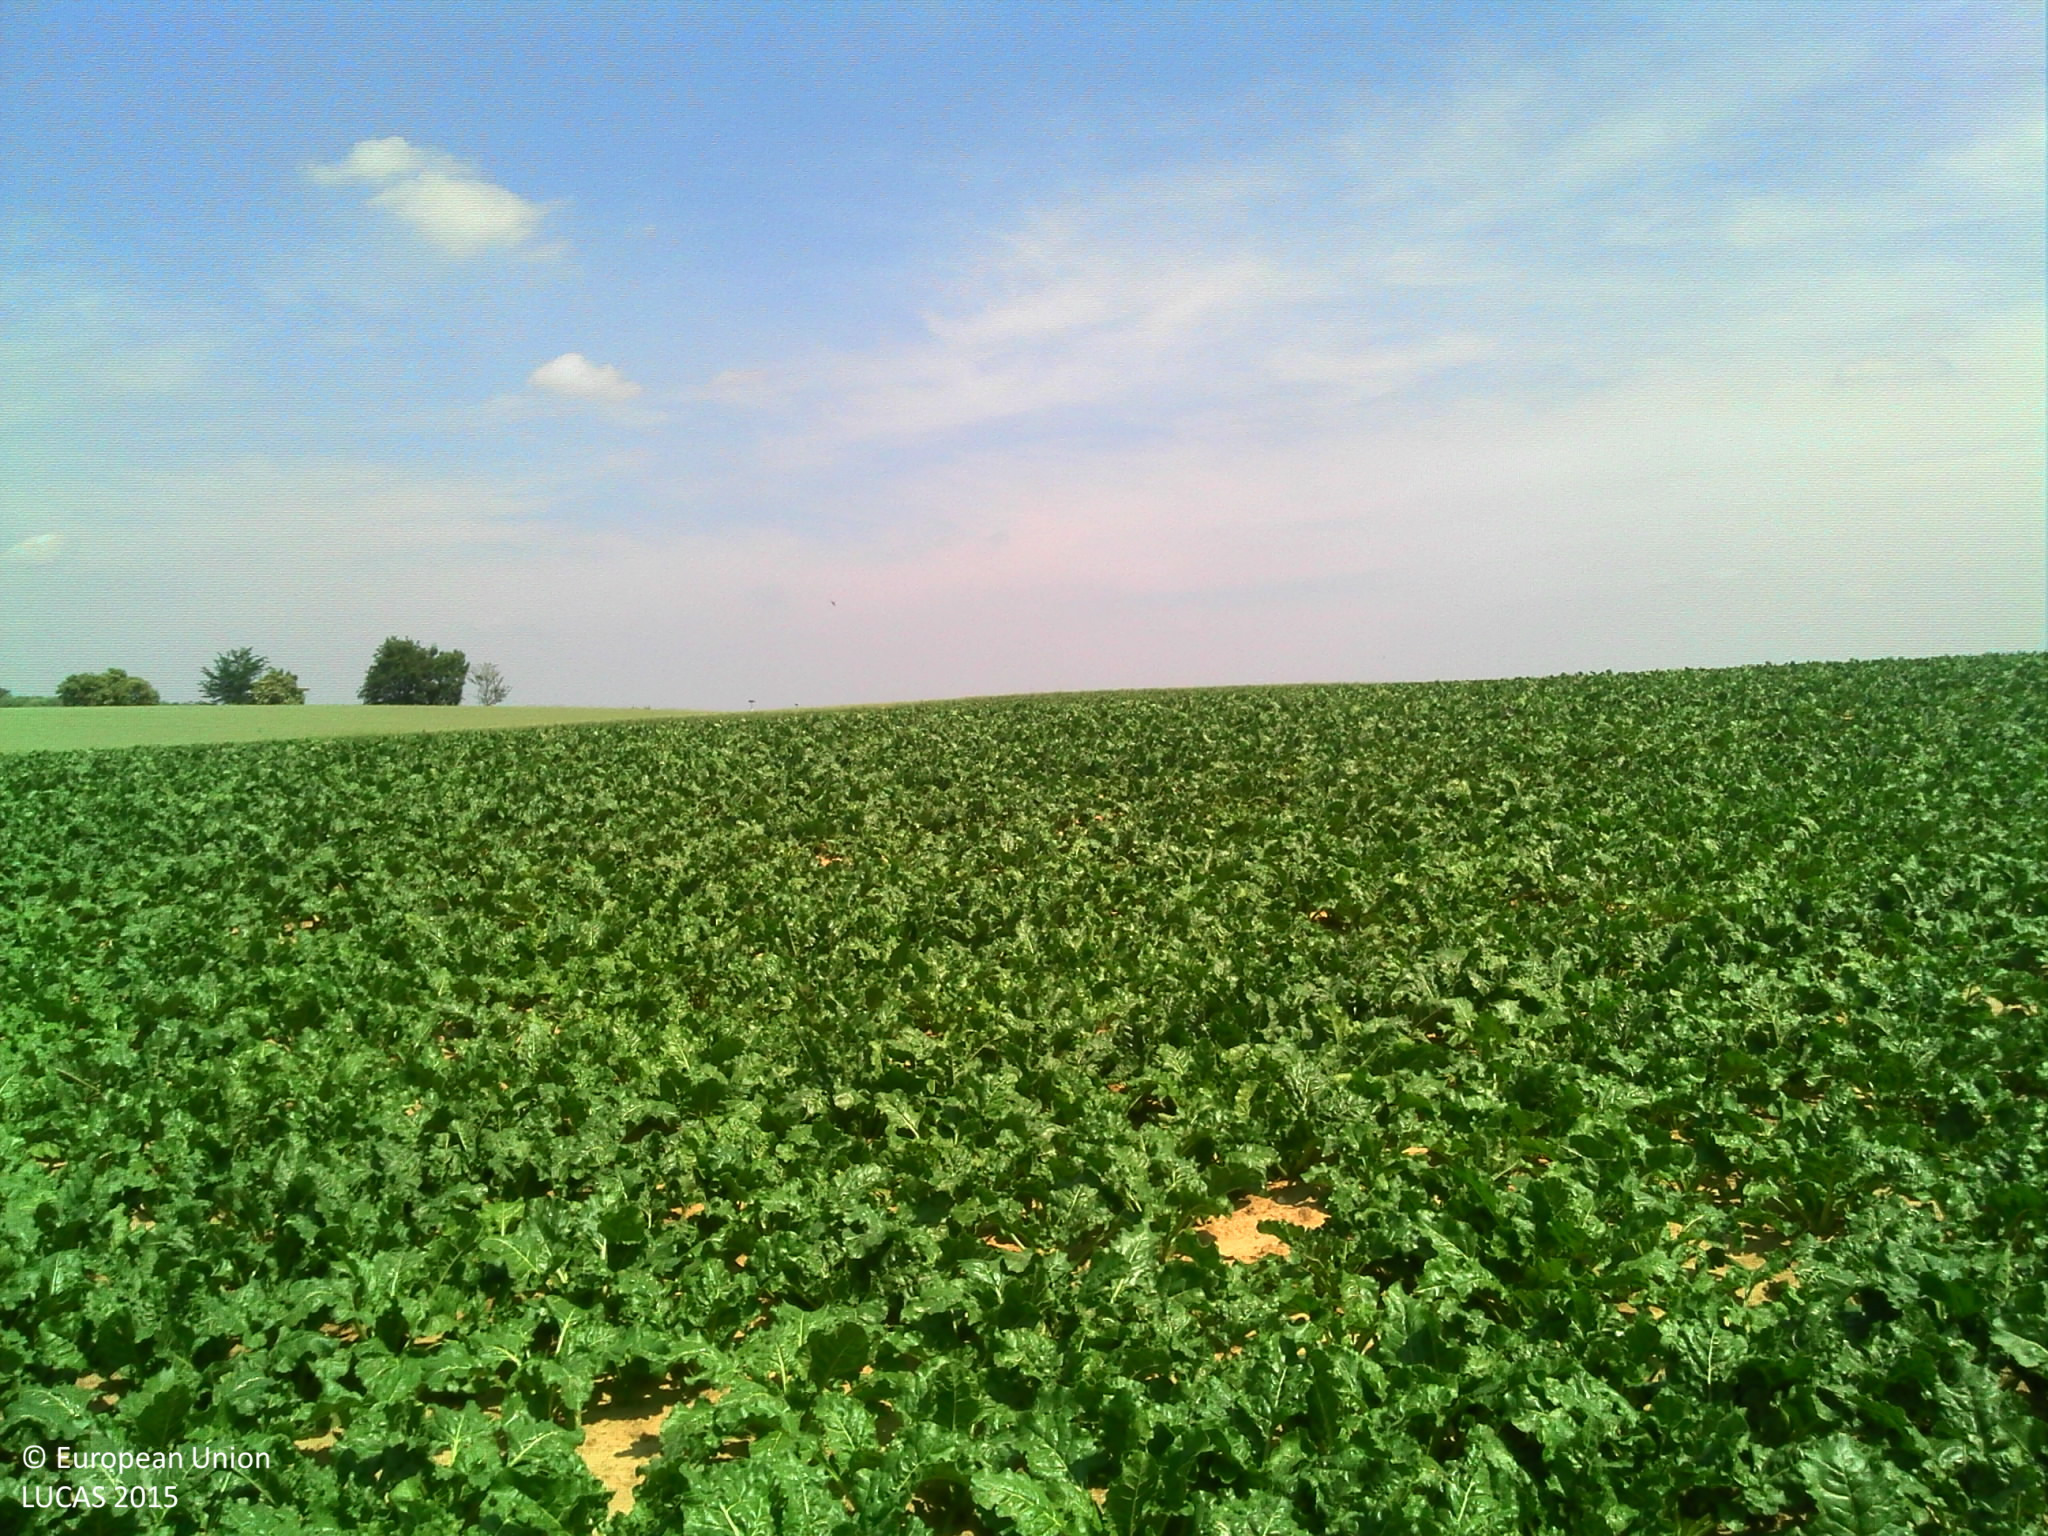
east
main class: Cropland
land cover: Sugar beet
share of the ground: > 75 %
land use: Agriculture (excluding fallow land and kitchen gardens)
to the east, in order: Sugar beet; Paved roads, cycling and walking lanes; Sugar beet; Common wheat
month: June
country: BE
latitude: 50.7755
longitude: 4.5646
